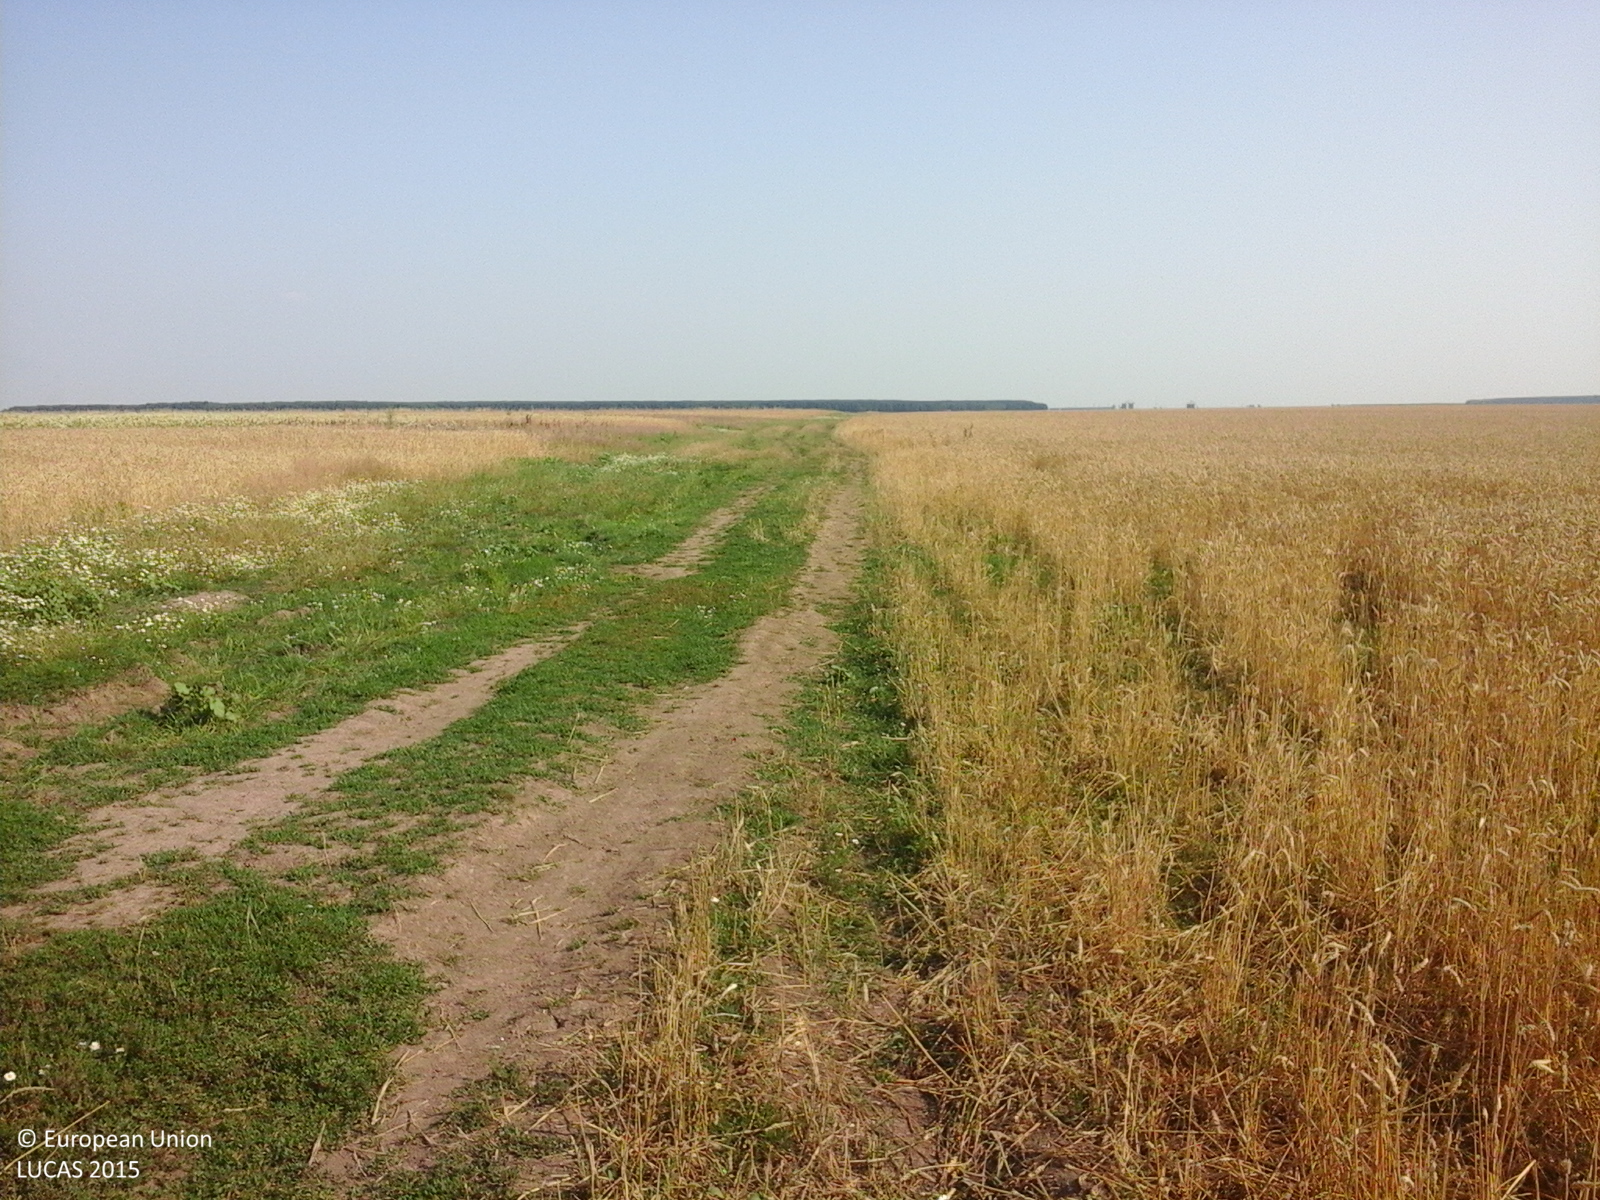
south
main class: Cropland
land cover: Common wheat
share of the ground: > 75 %
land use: Agriculture (excluding fallow land and kitchen gardens)
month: July
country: RO
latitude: 44.6245
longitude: 24.5036
